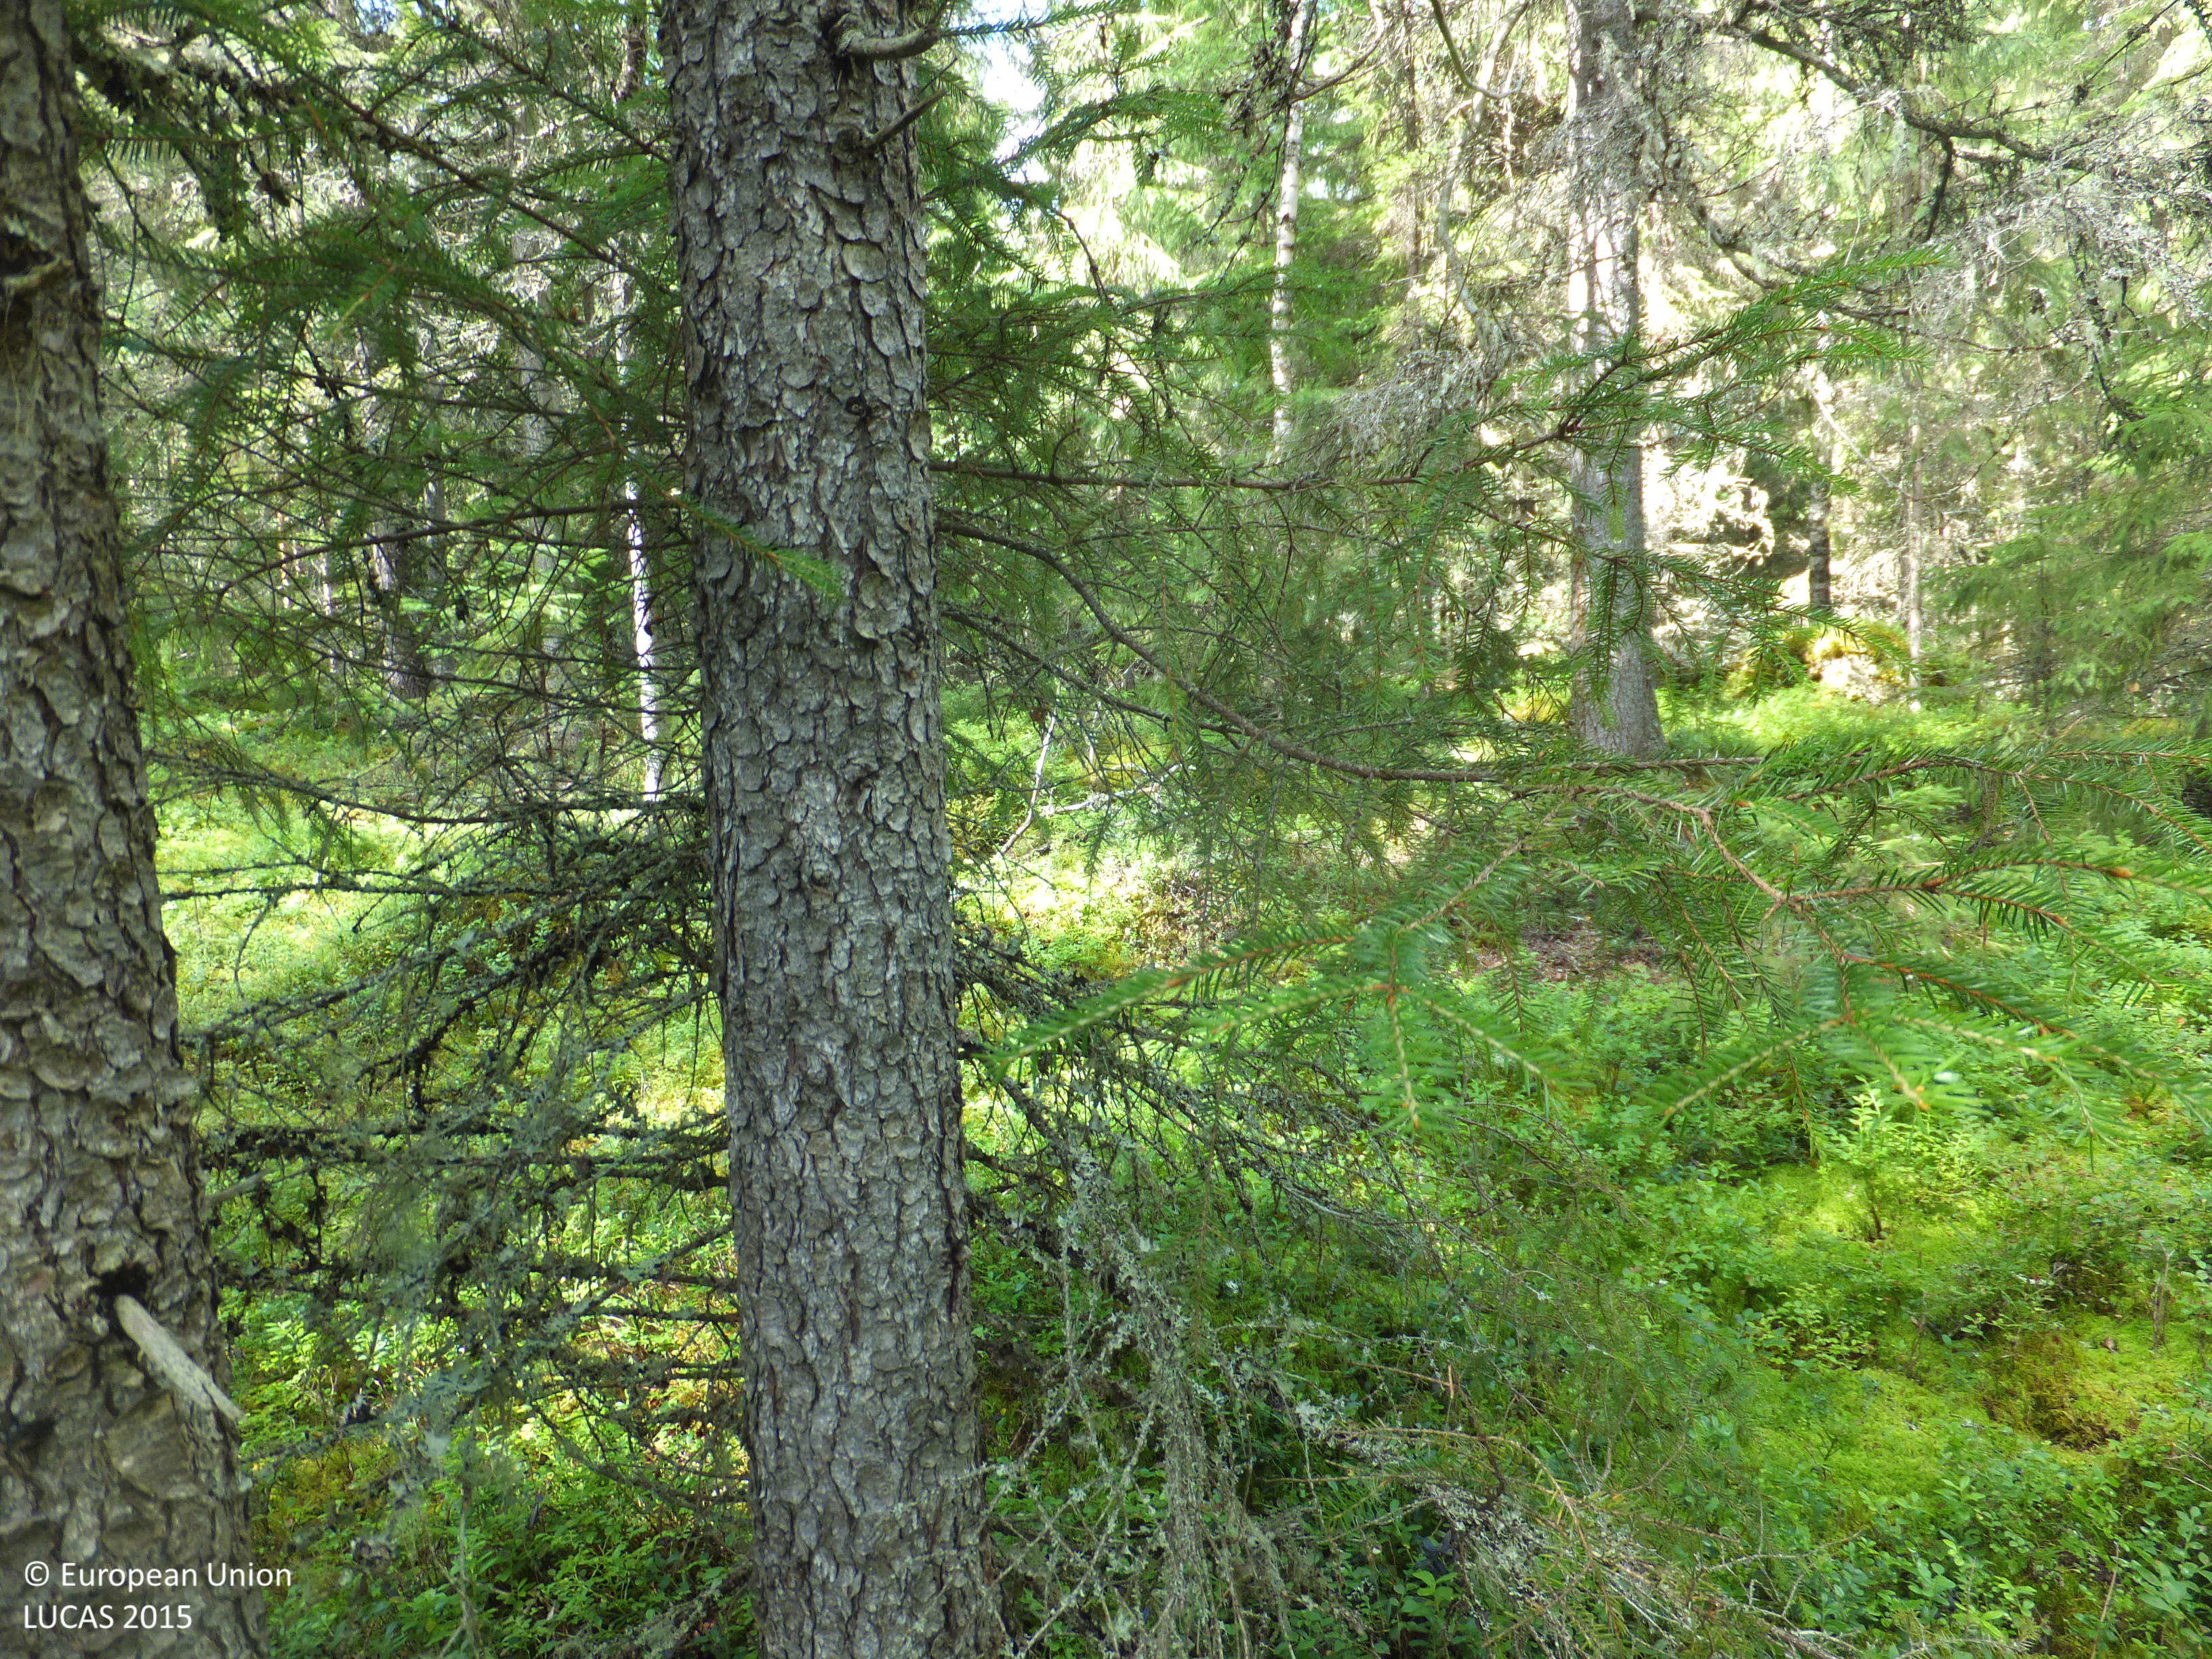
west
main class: Woodland
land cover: Spruce dominated coniferous woodland
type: boreal forest
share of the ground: 50 - 75 %
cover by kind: coniferous forest trees 65 %, shrubs 15 %, lichens and mosses 10 %, broadleaved forest trees 5 %, herbaceous plants 5 %
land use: Forestry
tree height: > 5 m
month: July
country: FI
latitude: 63.2743
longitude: 22.1023
